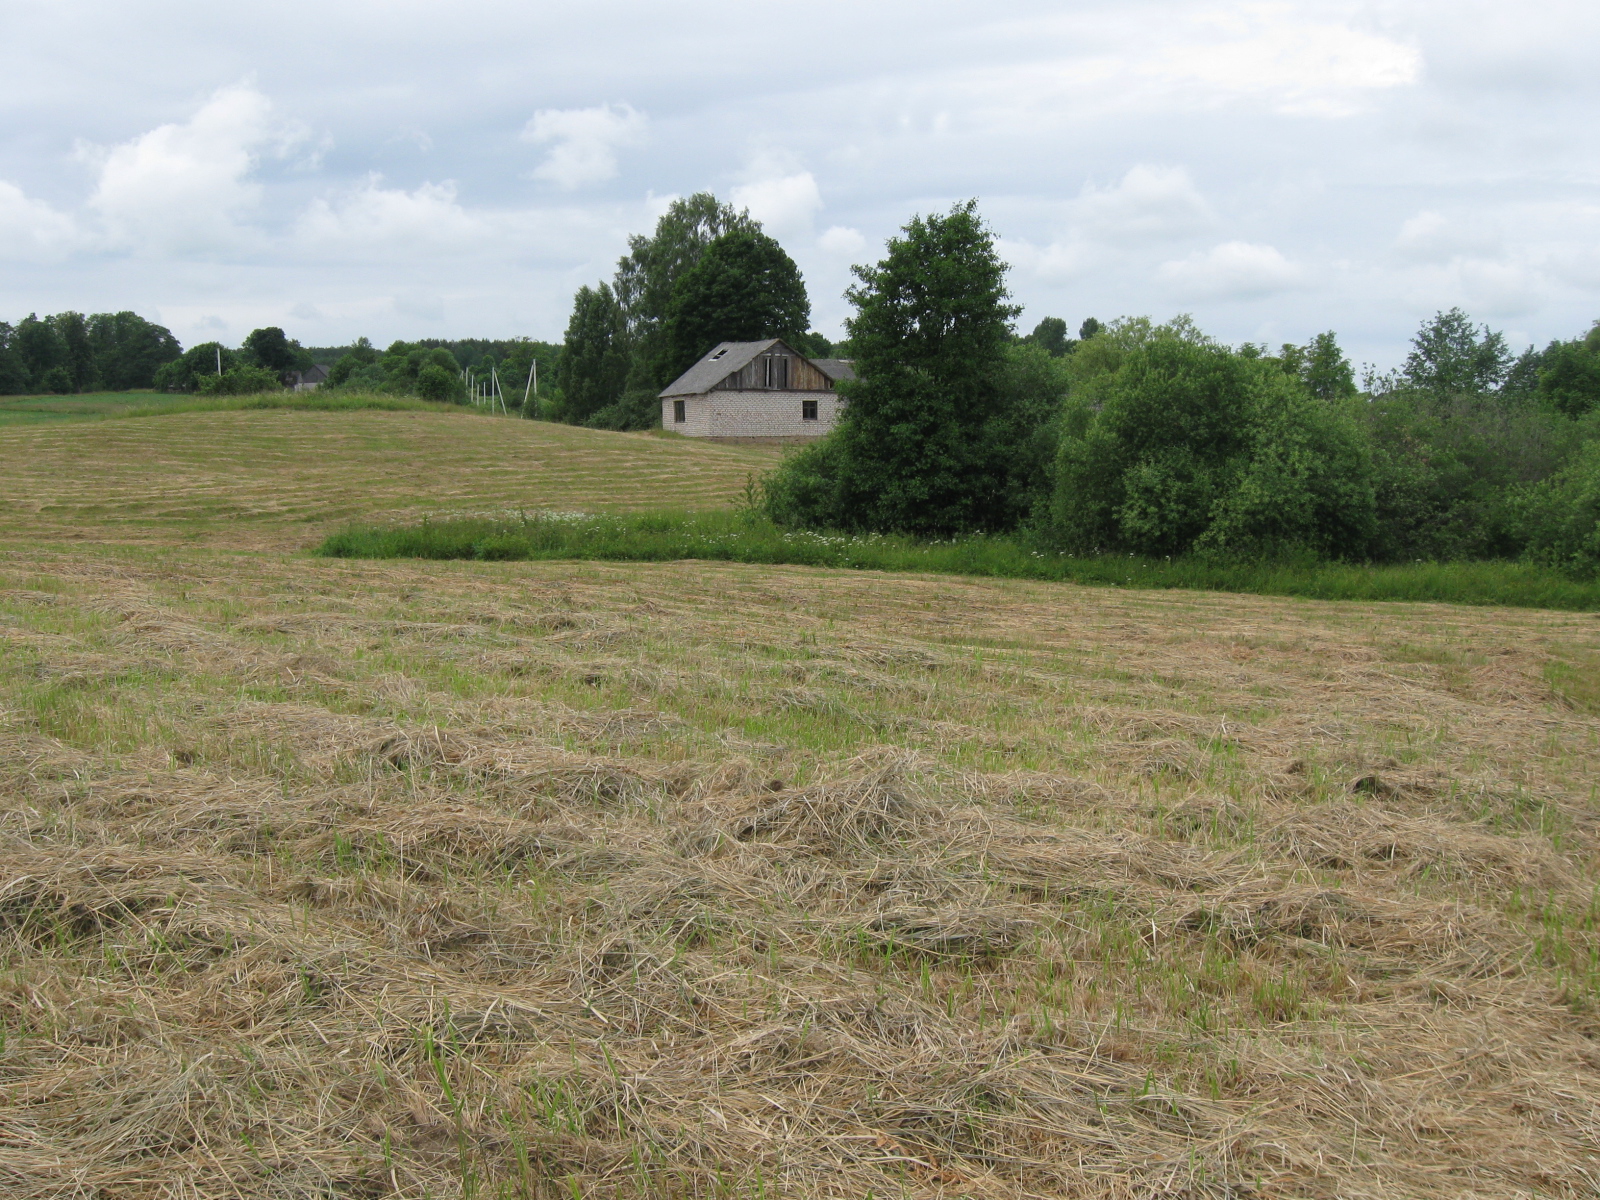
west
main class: Grassland
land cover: Grassland without tree/shrub cover
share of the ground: > 75 %
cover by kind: herbaceous plants 90 %, unconsolidated bare surface 10 %
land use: Agriculture (excluding fallow land and kitchen gardens)
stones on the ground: < 10 %
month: June
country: LT
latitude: 54.7709
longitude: 24.5124
